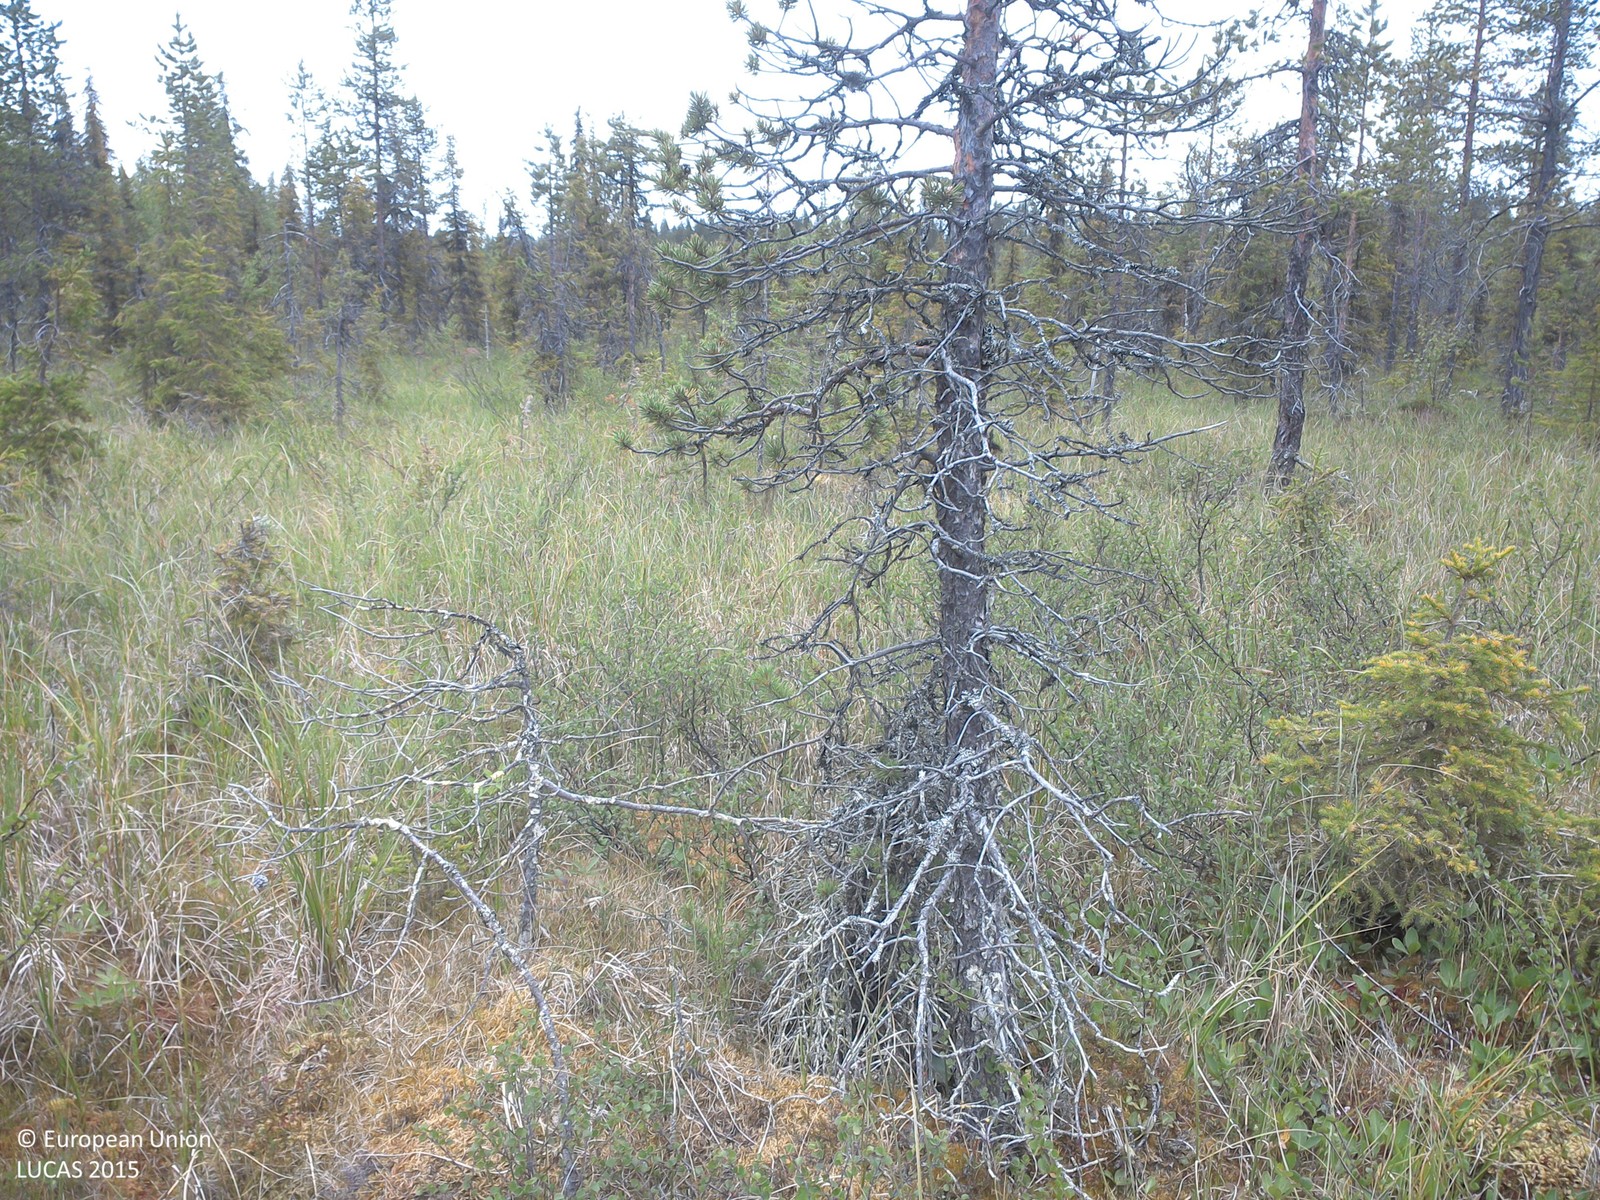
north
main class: Woodland
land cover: Pine dominated coniferous woodland
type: boreal forest
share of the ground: 10 - 25 %
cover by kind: herbaceous plants 55 %, lichens and mosses 25 %, coniferous forest trees 10 %, shrubs 10 %
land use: Semi-natural and natural areas not in use
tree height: < 5 m
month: July
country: SE
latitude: 67.5154
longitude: 22.3042
